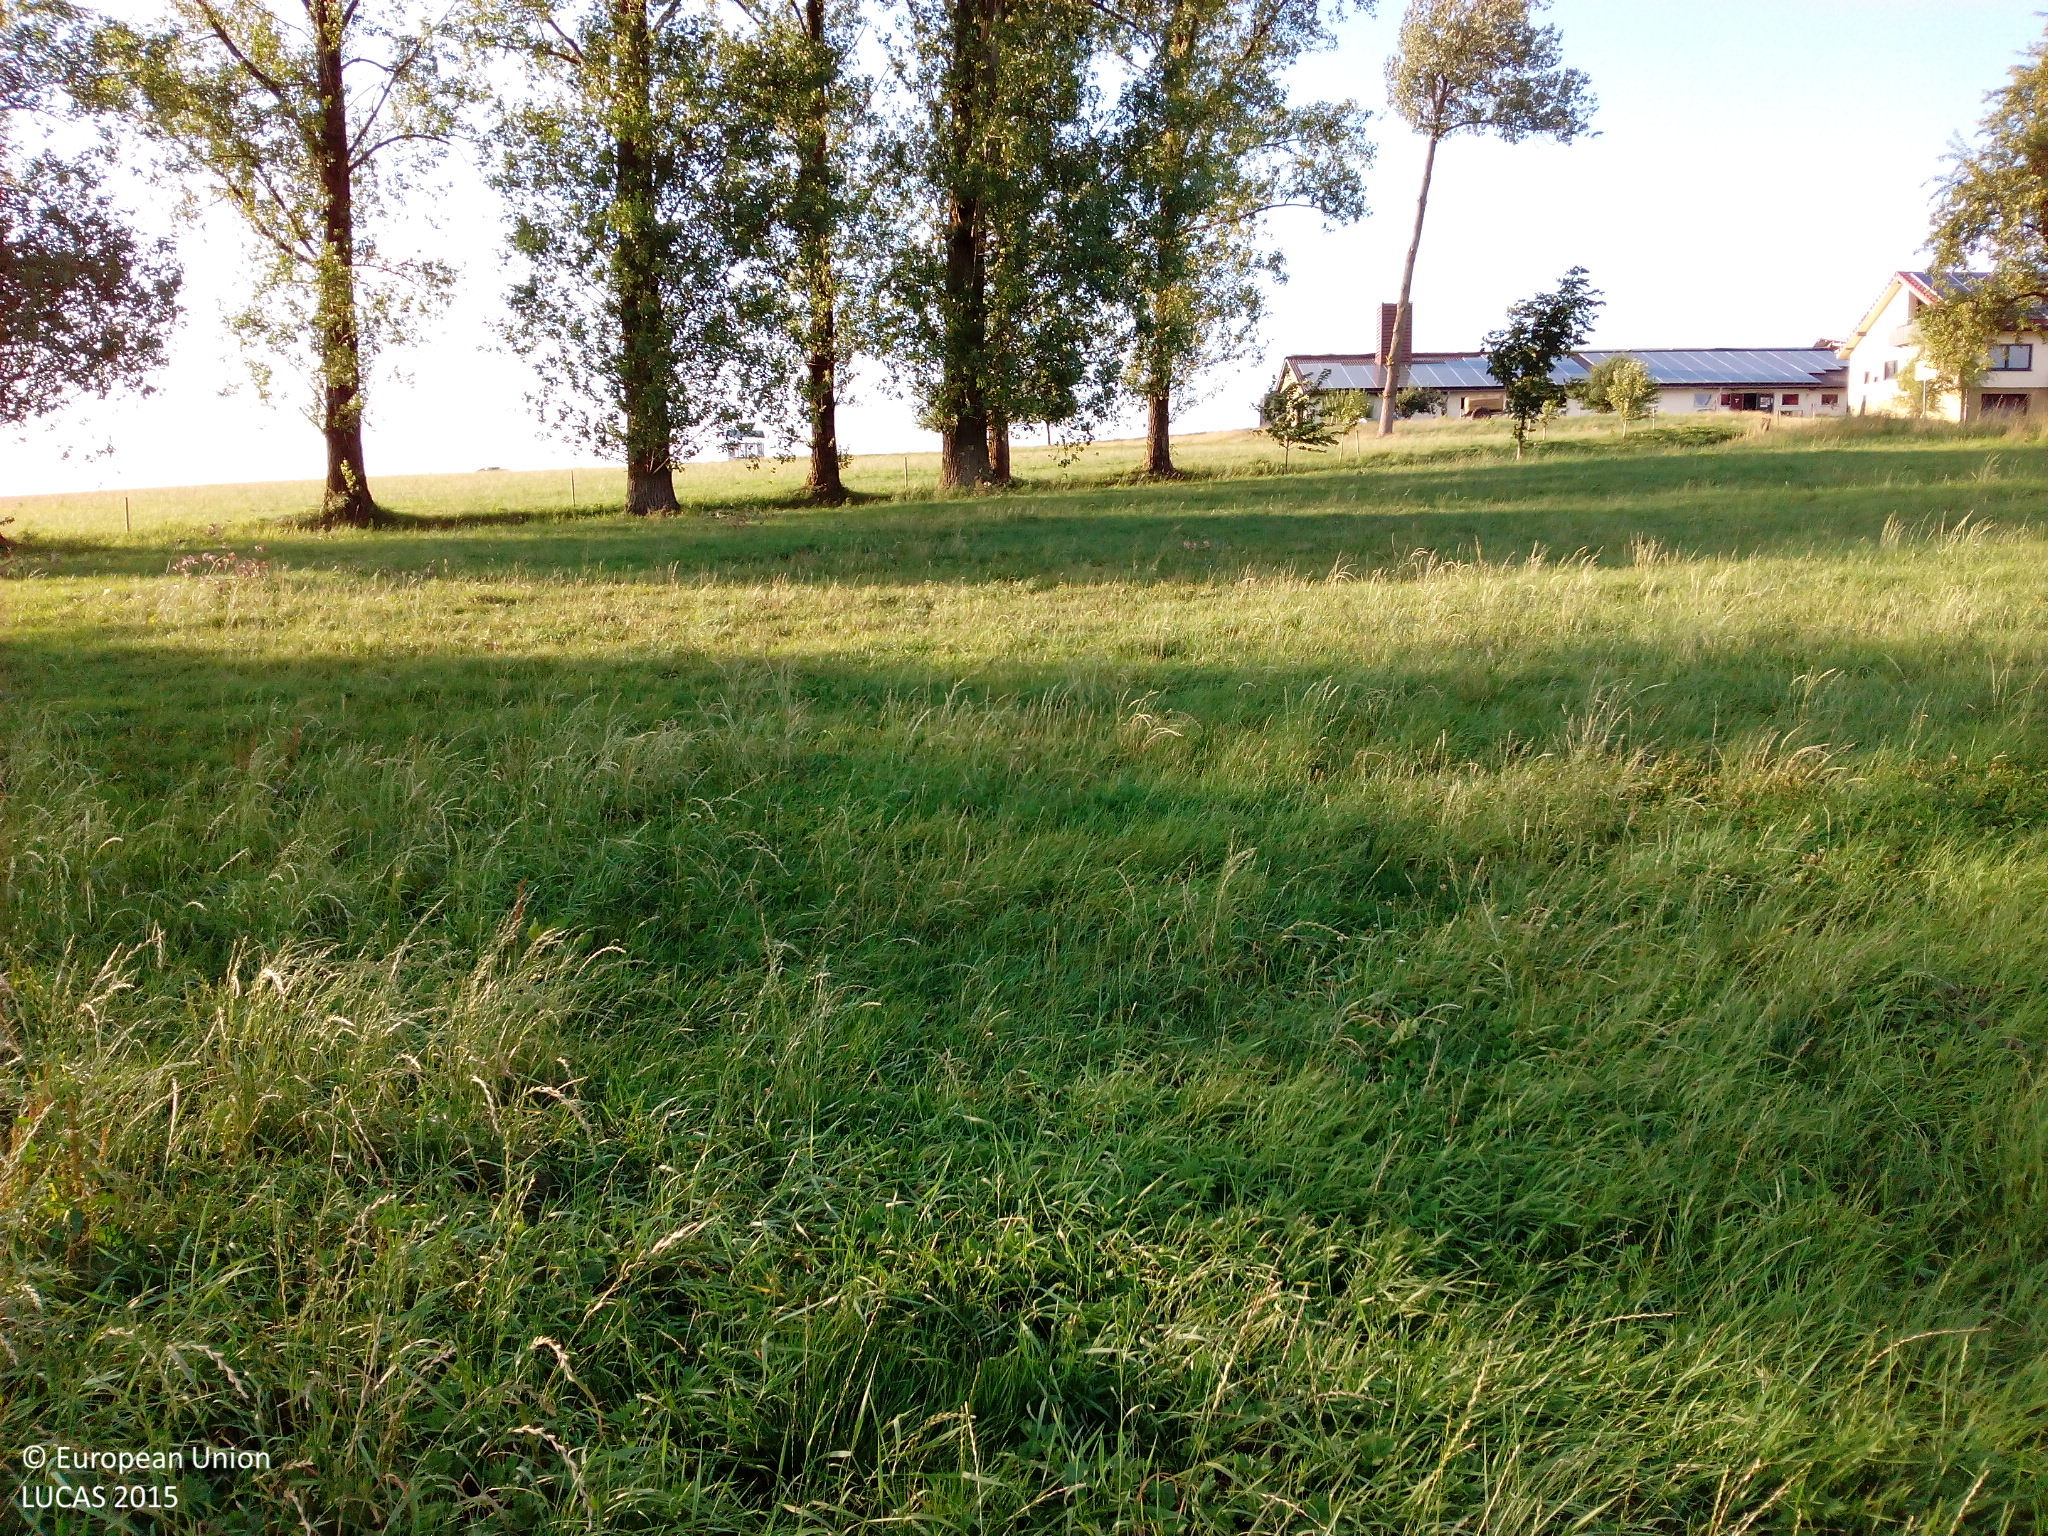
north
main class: Grassland
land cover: Grassland without tree/shrub cover
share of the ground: > 75 %
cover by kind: herbaceous plants 100 %
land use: Agriculture (excluding fallow land and kitchen gardens)
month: July
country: DE
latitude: 48.9429
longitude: 10.2593
